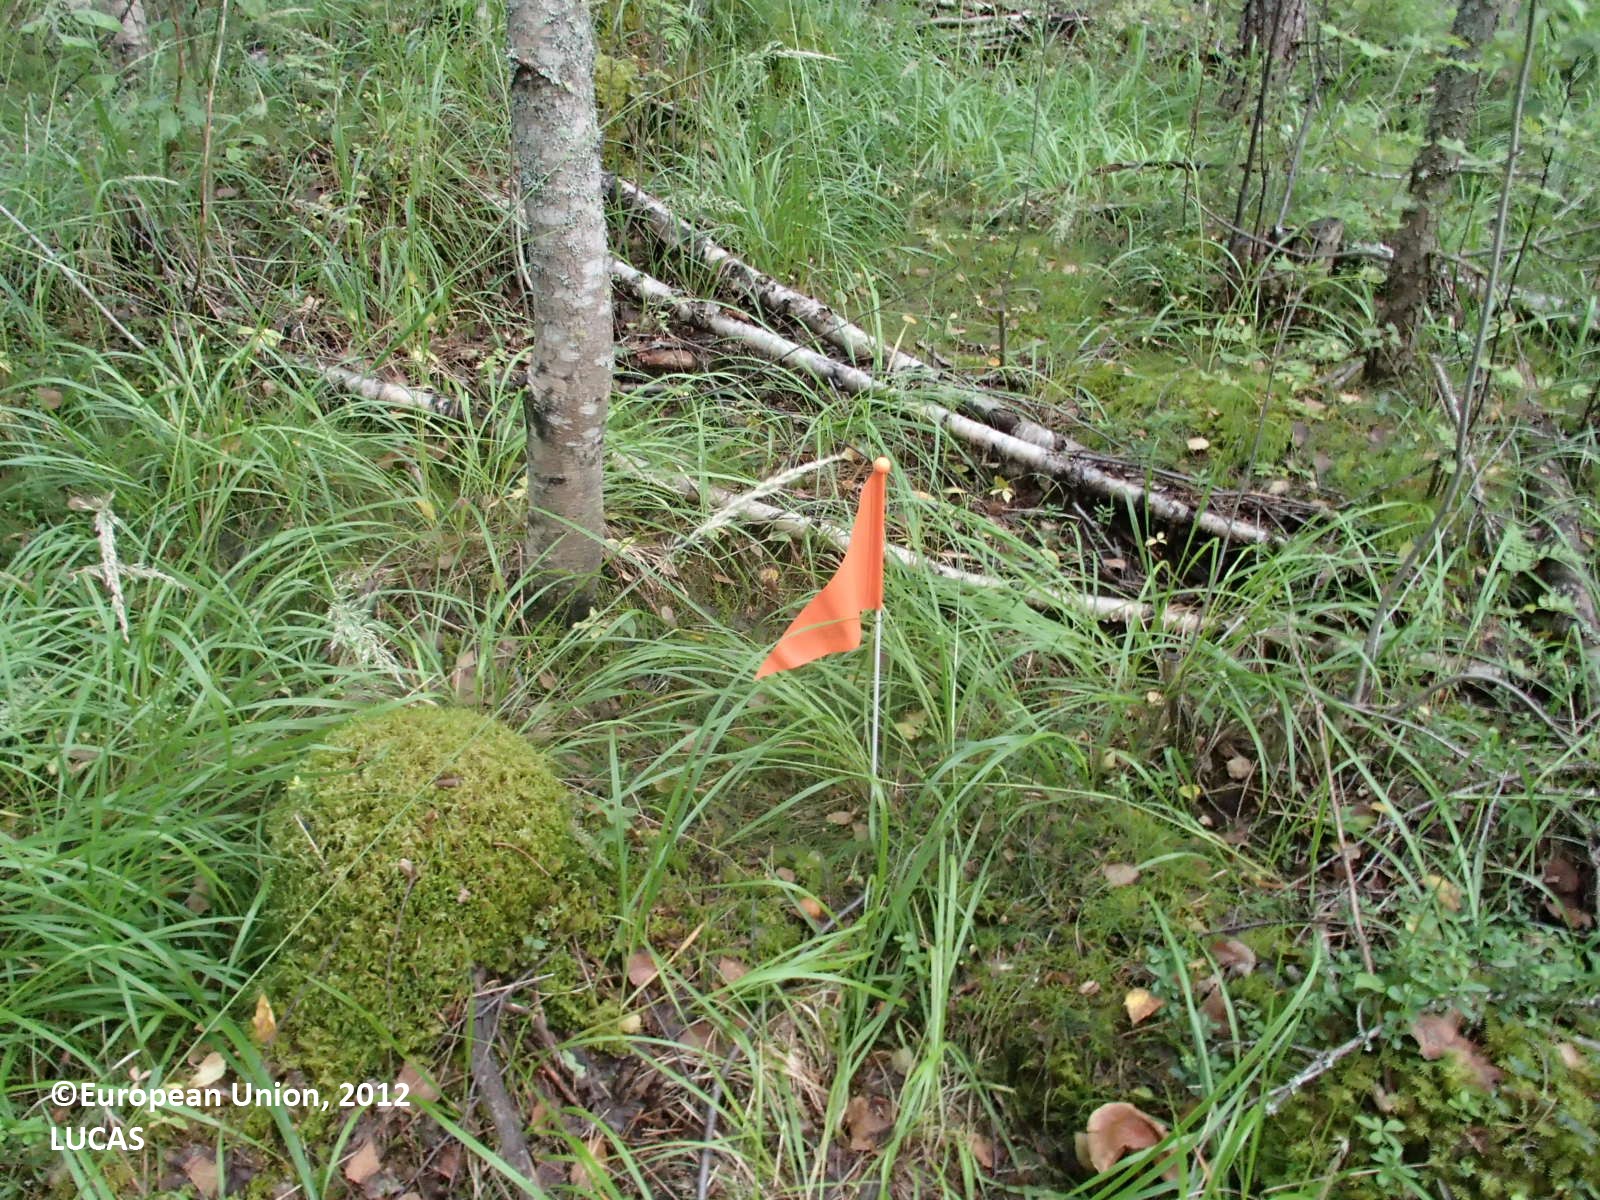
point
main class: Woodland
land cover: Pine dominated mixed woodland
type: boreal forest
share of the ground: > 75 %
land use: Forestry
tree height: > 5 m
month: August
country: FI
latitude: 63.5519
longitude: 28.0641
